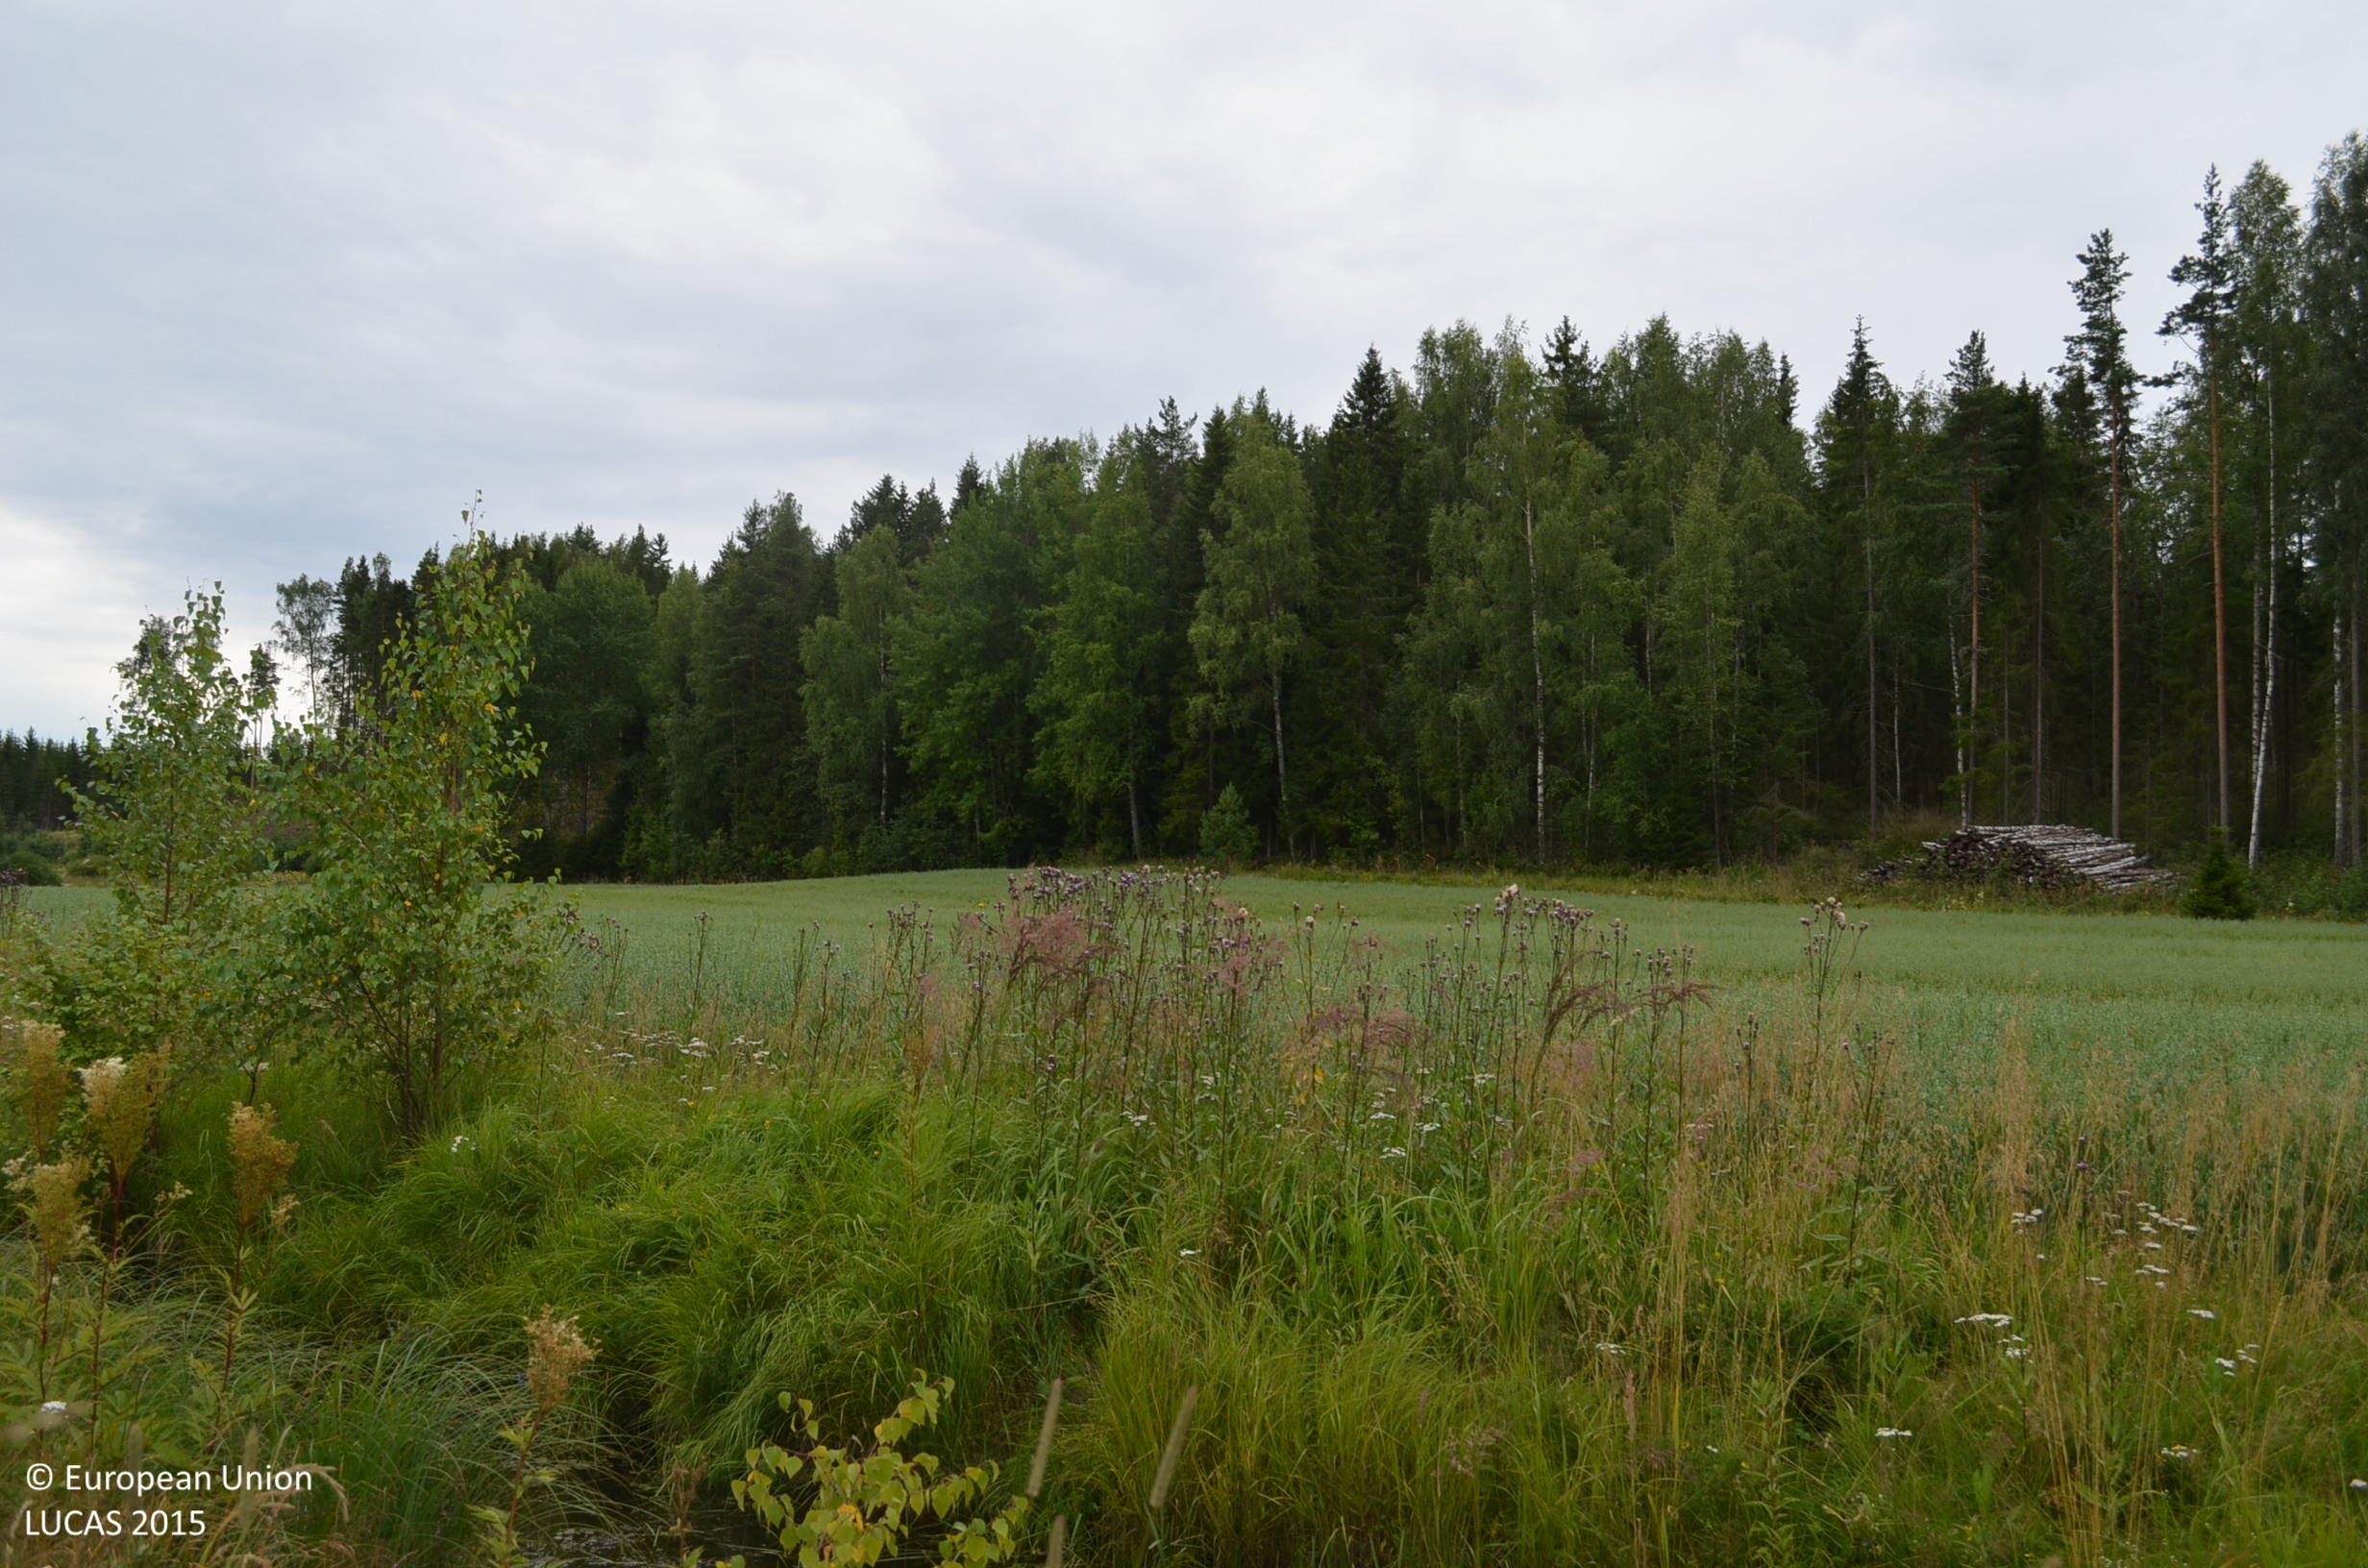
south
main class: Cropland
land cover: Mixed cereals for fodder
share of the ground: > 75 %
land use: Agriculture (excluding fallow land and kitchen gardens)
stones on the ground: < 10 %
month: August
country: FI
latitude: 61.5668
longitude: 23.2345
